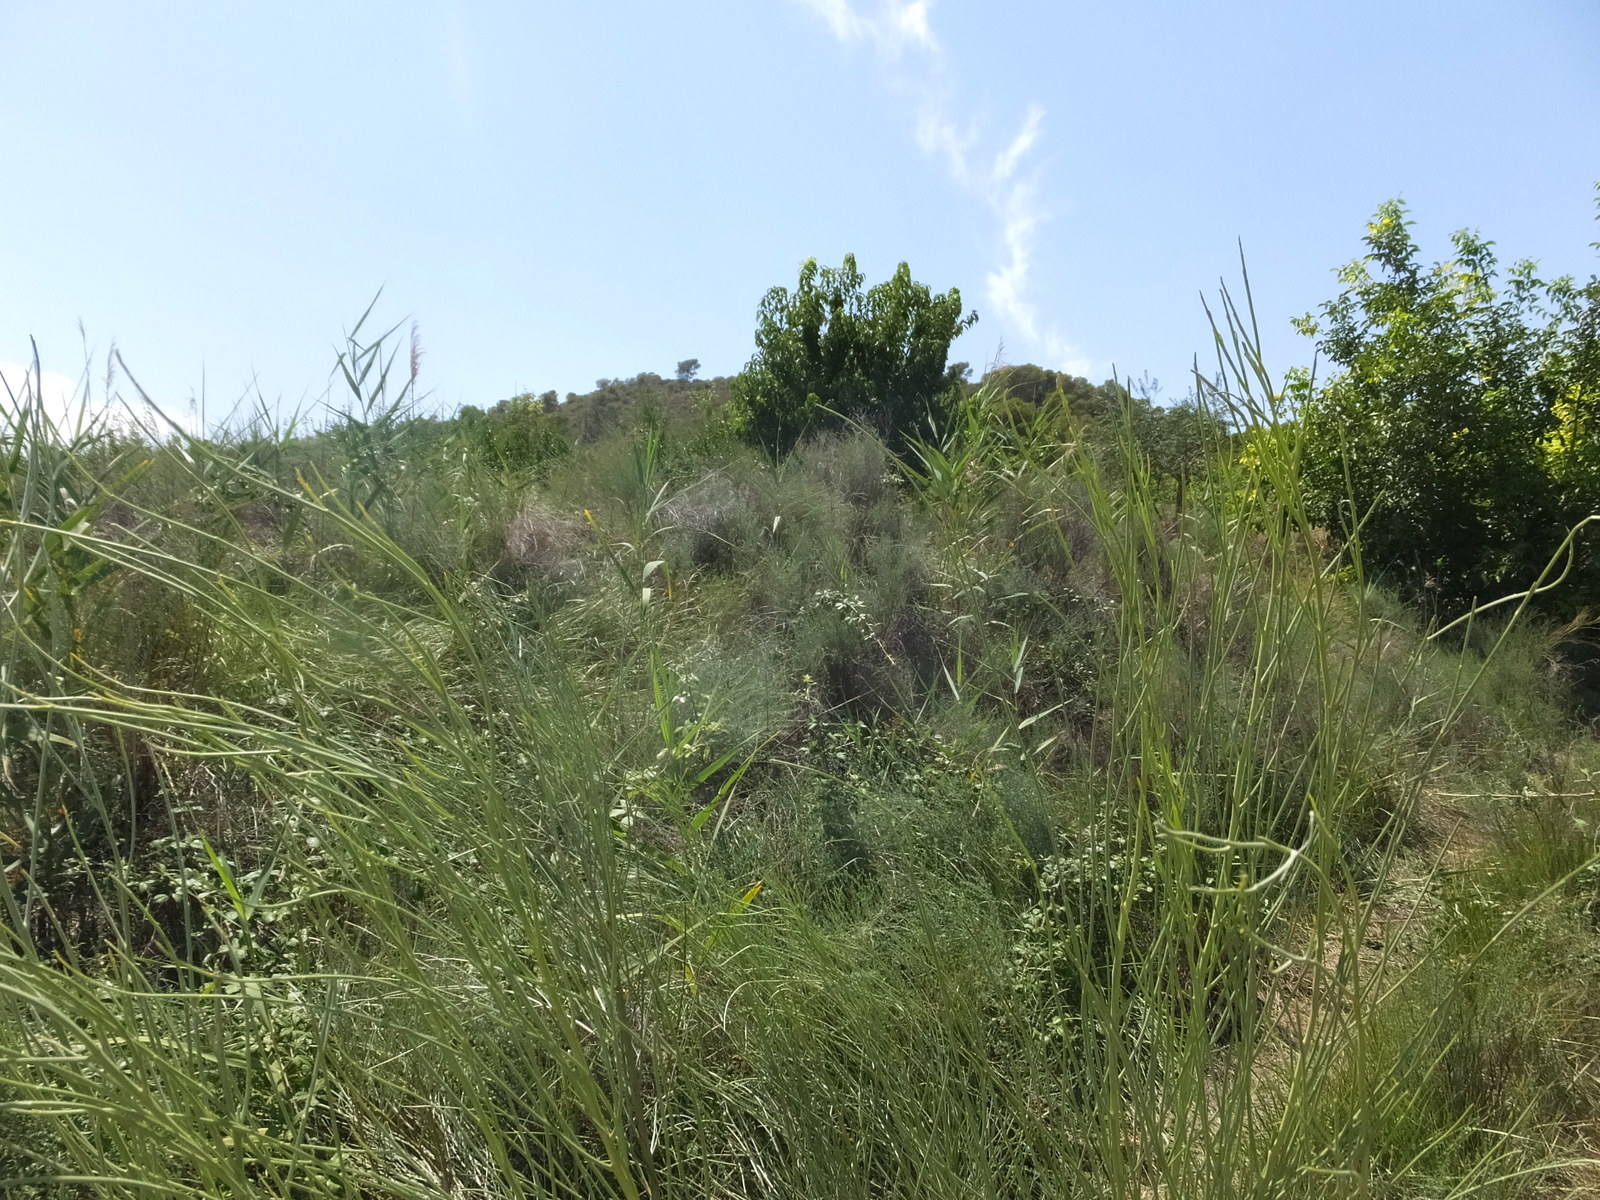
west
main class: Shrubland
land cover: Shrubland without tree cover
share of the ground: > 75 %
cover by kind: shrubs 75 %, herbaceous plants 25 %
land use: Semi-natural and natural areas not in use
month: July
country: ES
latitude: 41.2314
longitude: 0.1940
